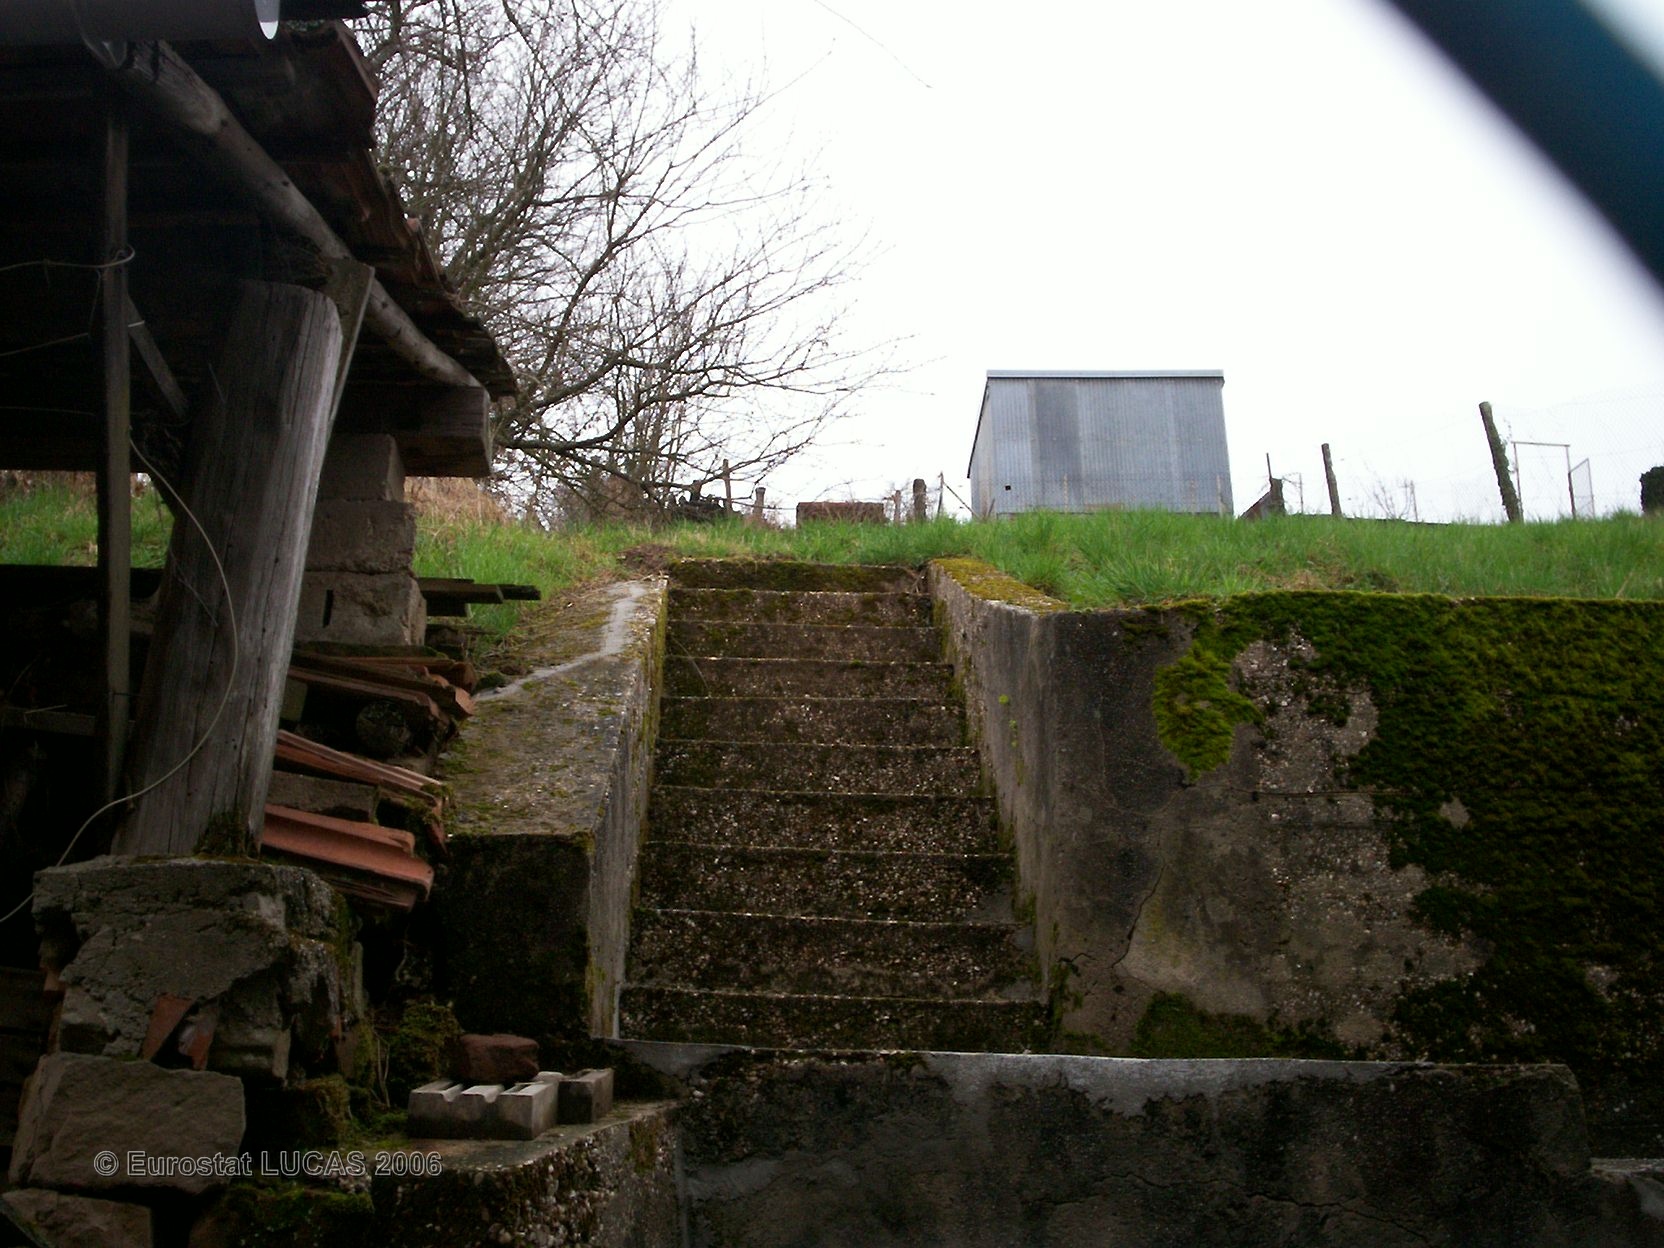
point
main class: Grassland
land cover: Grassland with sparse tree/shrub cover
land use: Residential
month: April
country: FR
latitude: 48.6711
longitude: 7.0811
